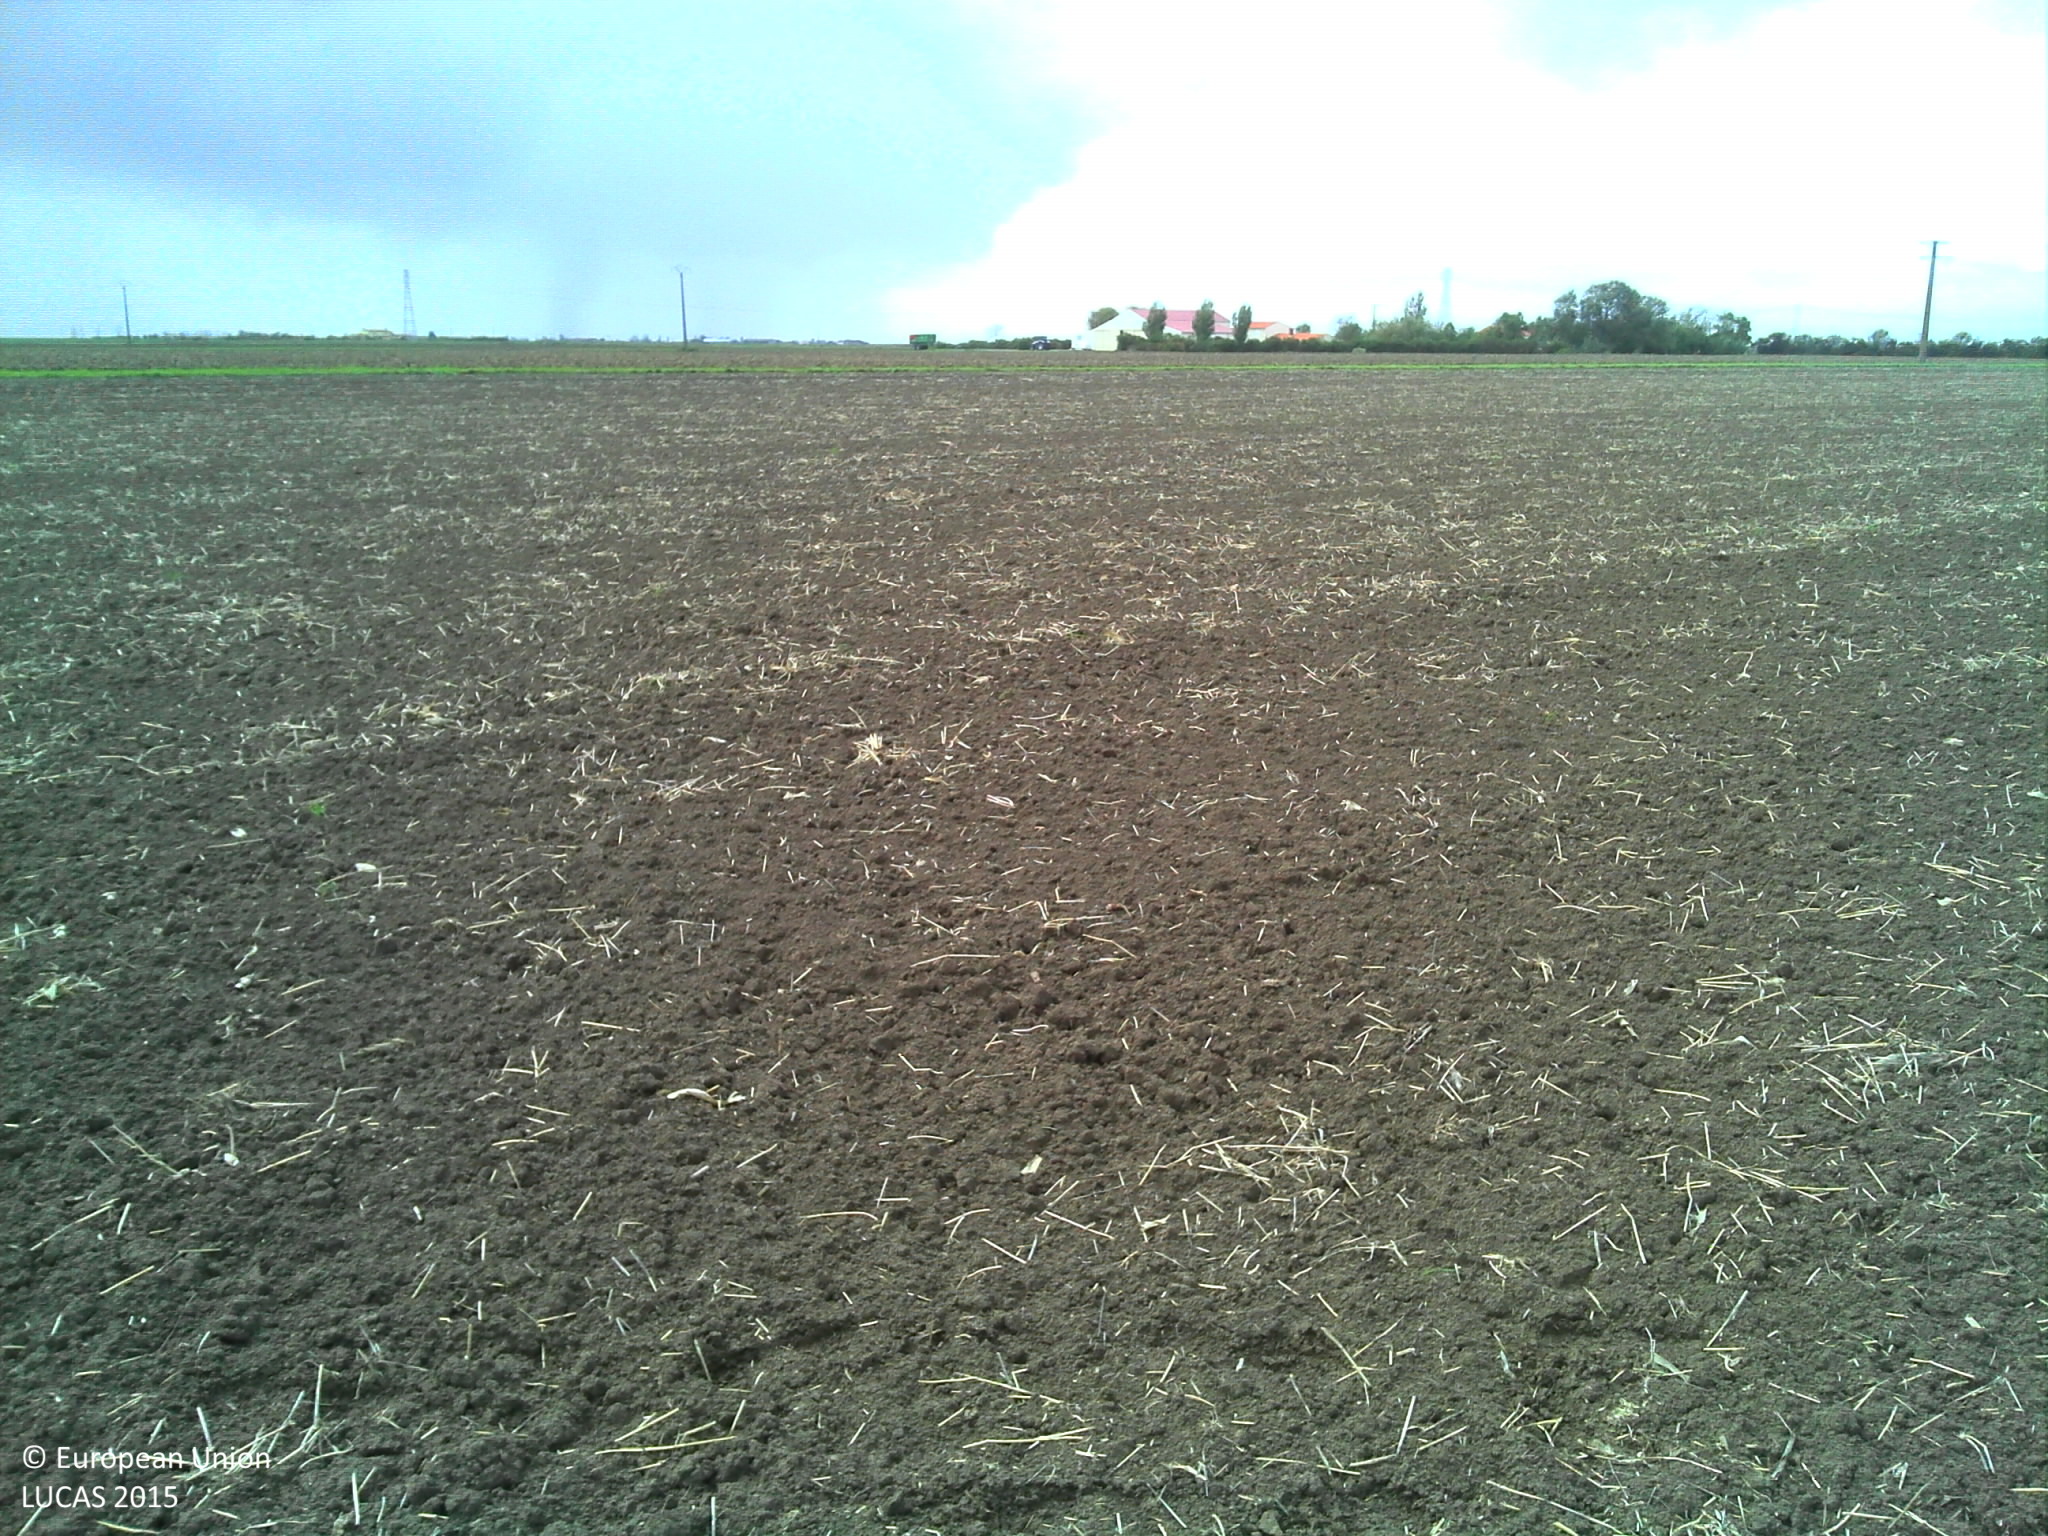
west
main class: Cropland
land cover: Maize
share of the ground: < 10 %
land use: Agriculture (excluding fallow land and kitchen gardens)
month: October
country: FR
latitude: 46.3362
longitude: -1.0877
